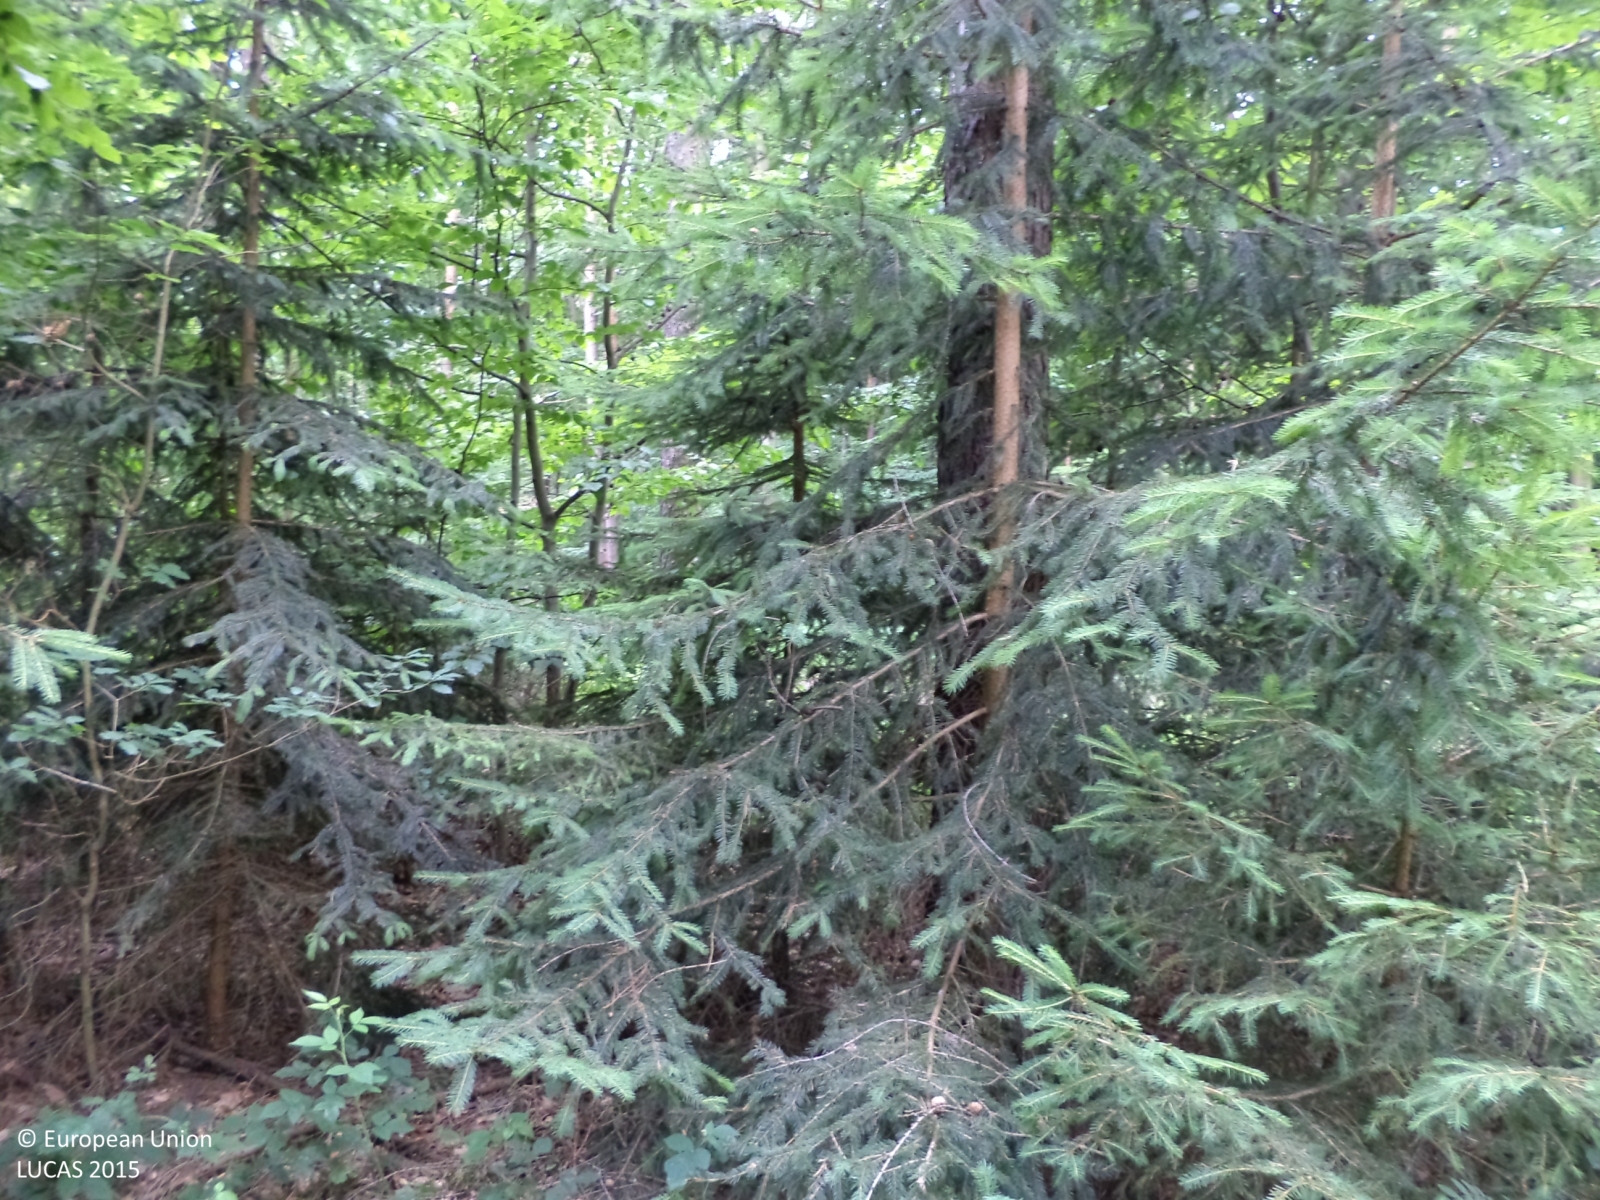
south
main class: Woodland
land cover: Spruce dominated mixed woodland
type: hemiboreal forest and nemoral coniferous forest and mixed broadleaved-coniferous forest
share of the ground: > 75 %
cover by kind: coniferous forest trees 70 %, broadleaved forest trees 30 %
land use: Forestry
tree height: > 5 m
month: July
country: CZ
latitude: 49.9540
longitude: 13.9452
